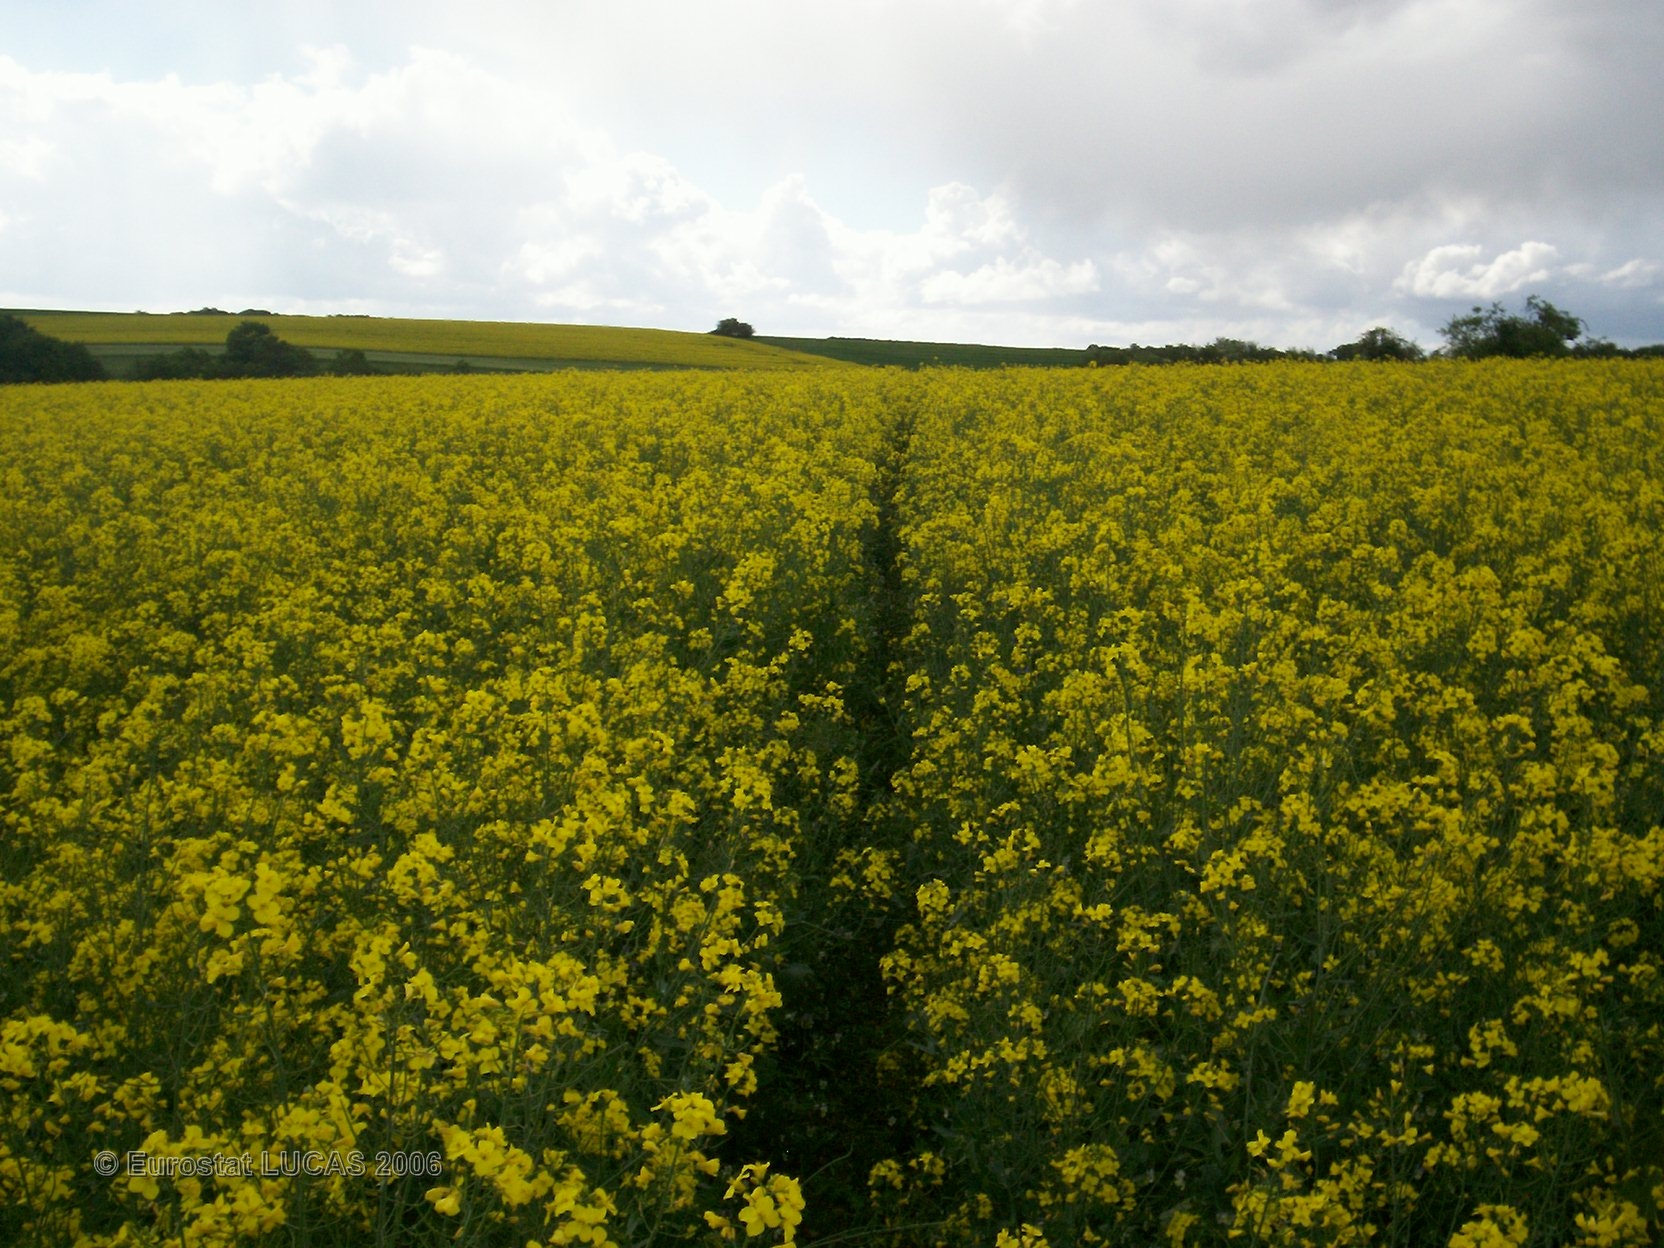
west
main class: Cropland
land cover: Rape and turnip rape
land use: Agriculture (excluding fallow land and kitchen gardens)
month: May
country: FR
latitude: 46.9933
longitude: 4.6486
